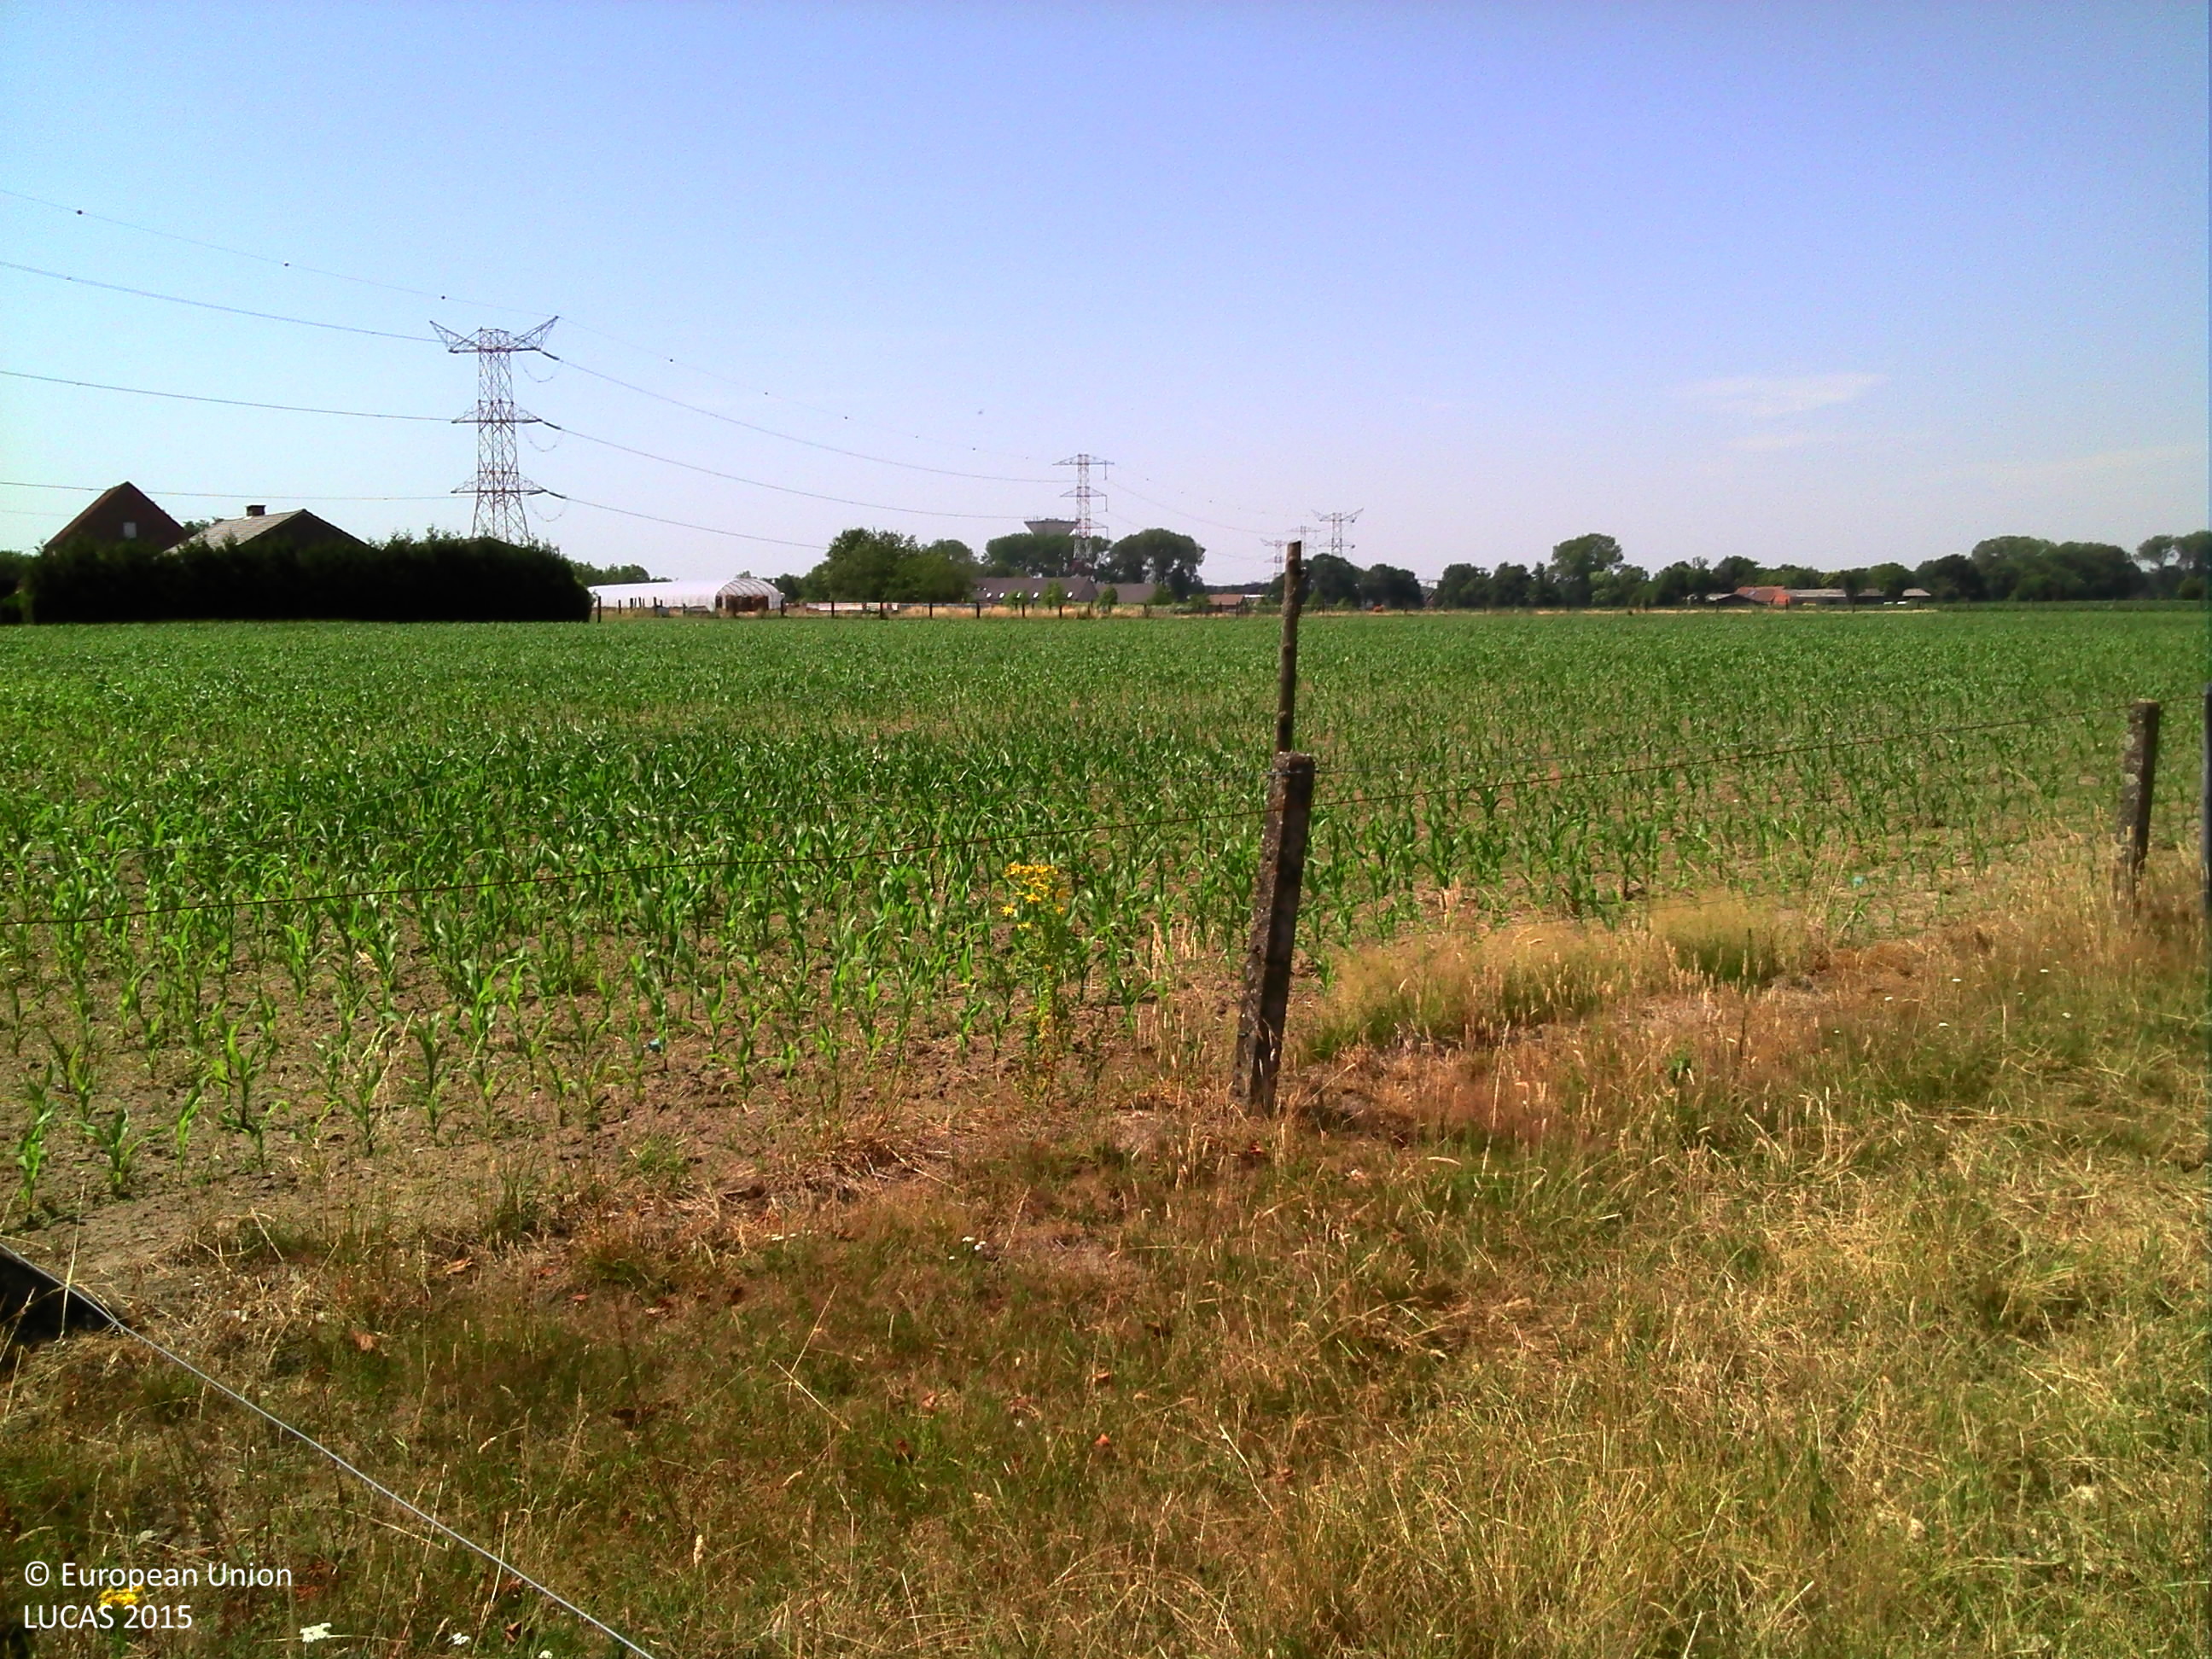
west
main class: Grassland
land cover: Grassland without tree/shrub cover
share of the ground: > 75 %
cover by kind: herbaceous plants 100 %
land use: Agriculture (excluding fallow land and kitchen gardens)
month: July
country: BE
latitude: 51.1387
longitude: 5.4674
